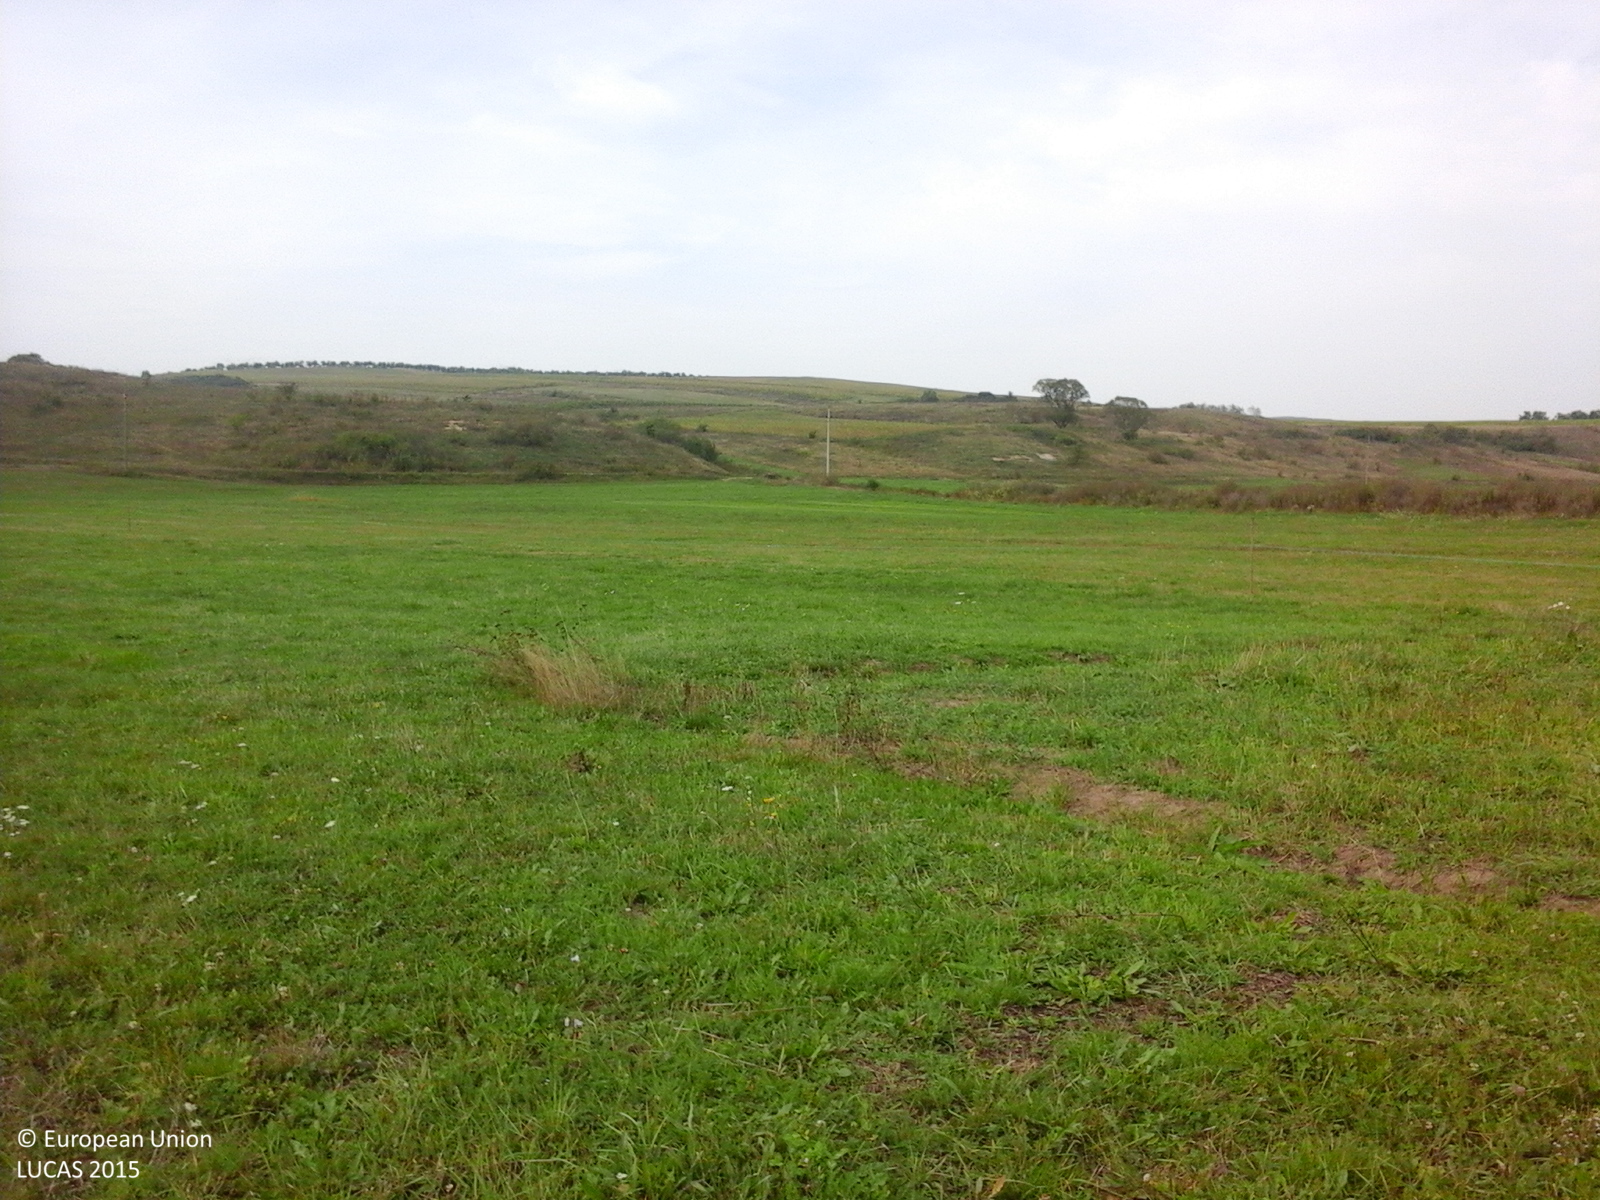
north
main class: Grassland
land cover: Grassland without tree/shrub cover
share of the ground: > 75 %
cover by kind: herbaceous plants 100 %
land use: Agriculture (excluding fallow land and kitchen gardens)
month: September
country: RO
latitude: 47.0246
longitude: 23.0493
